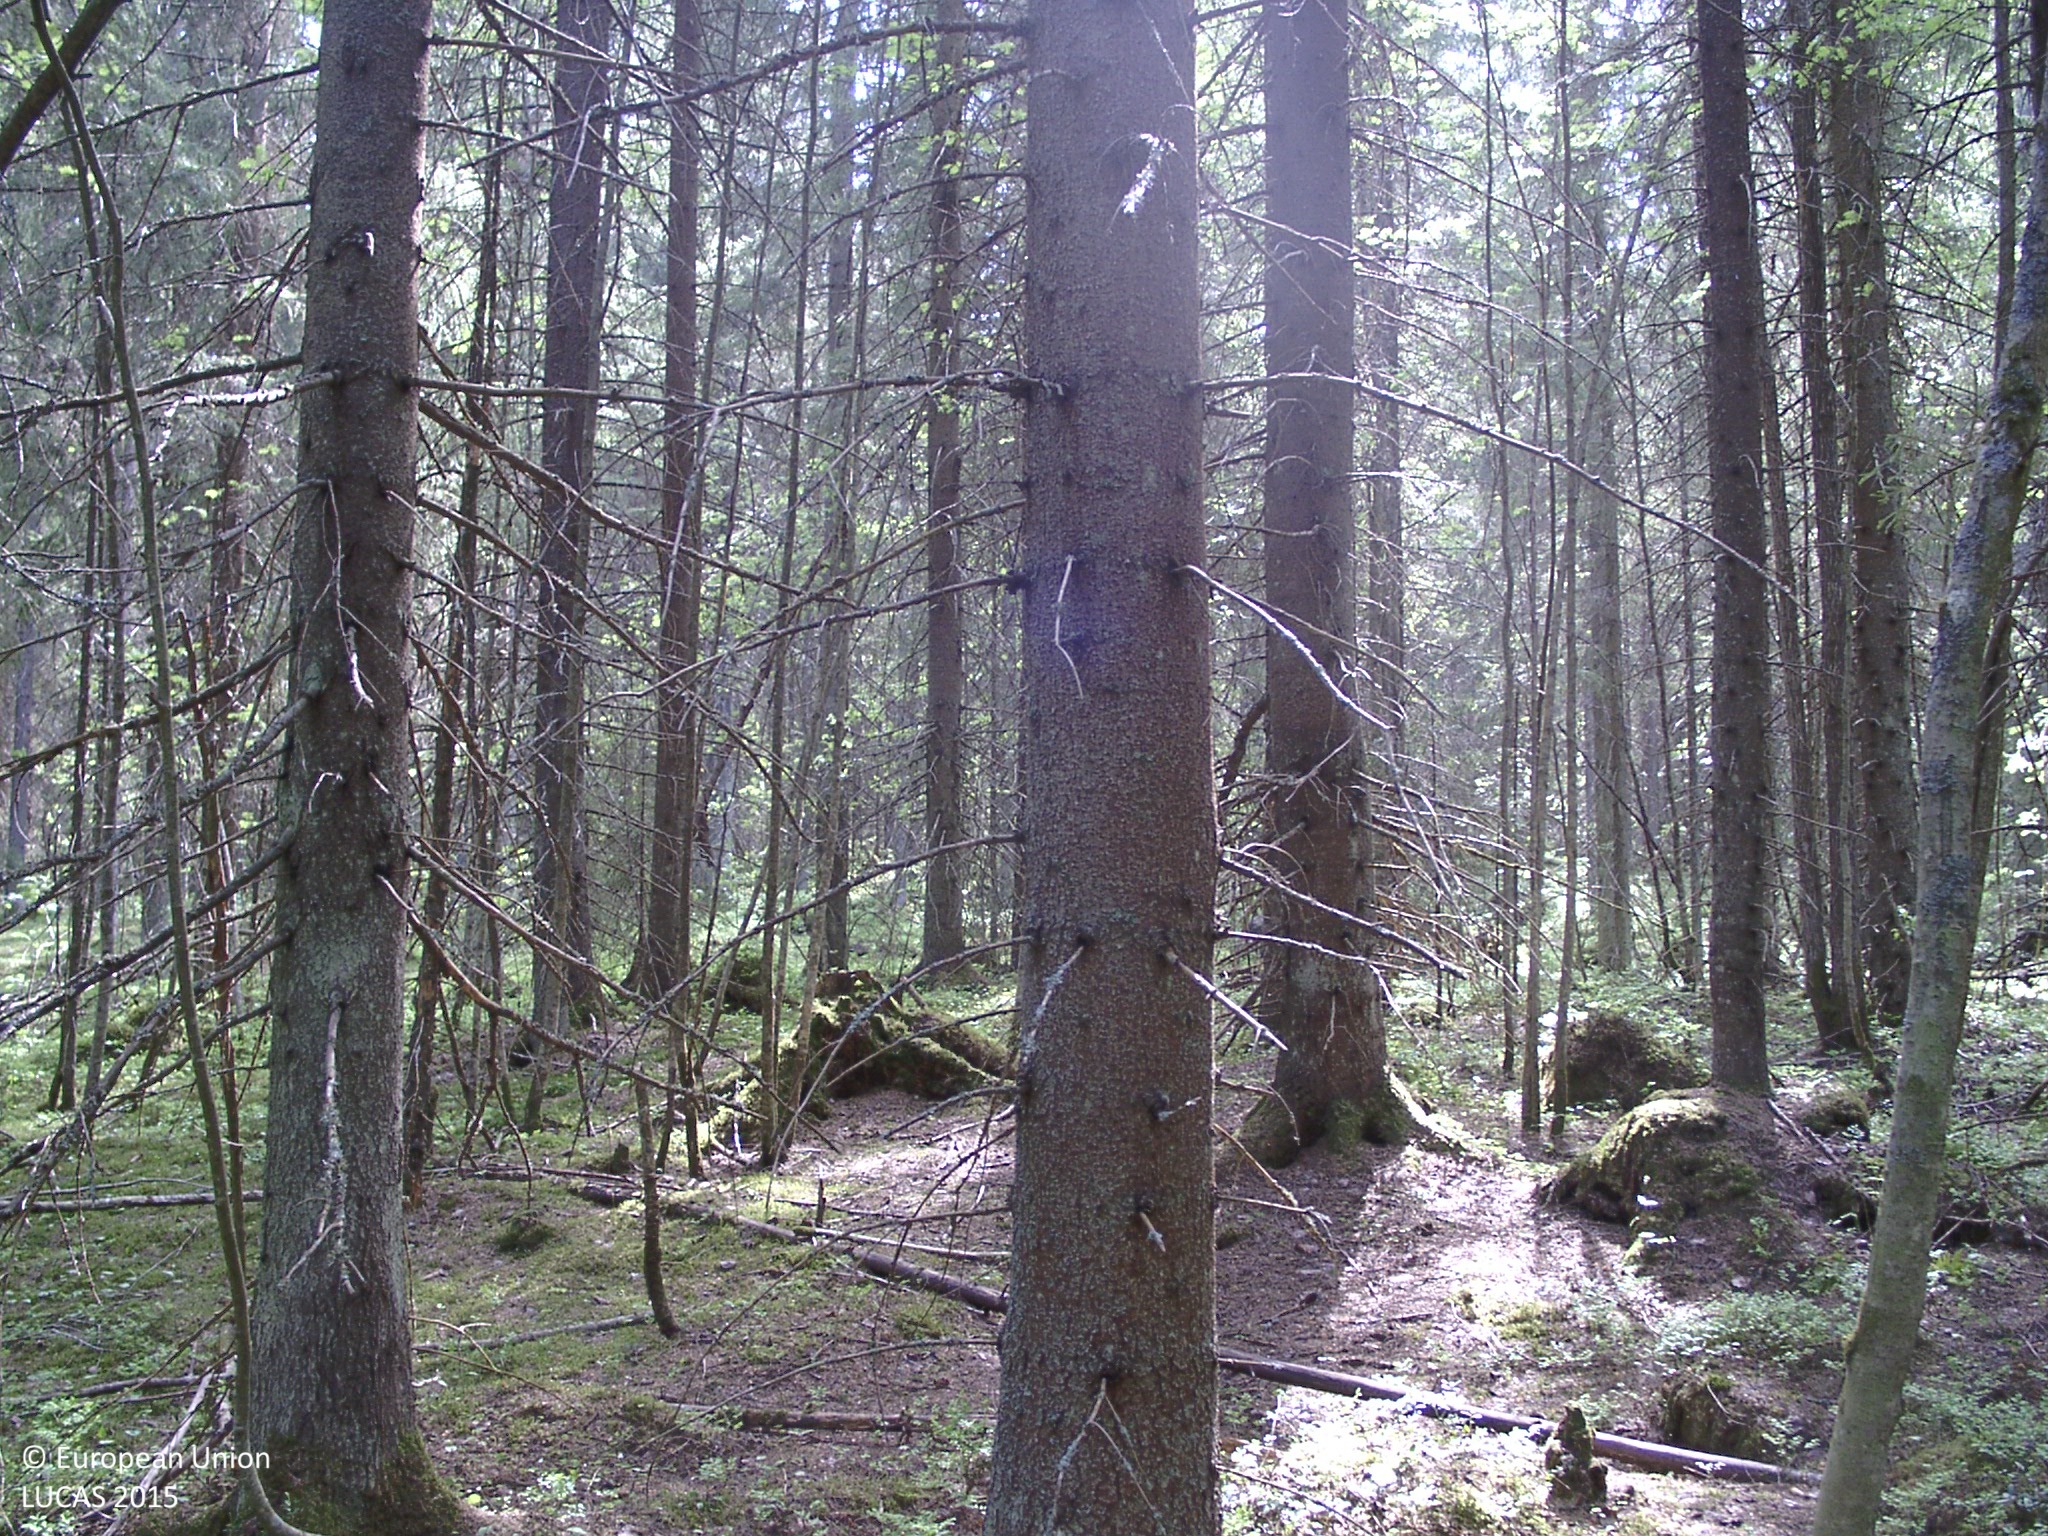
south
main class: Woodland
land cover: Spruce dominated coniferous woodland
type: boreal forest
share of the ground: > 75 %
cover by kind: coniferous forest trees 70 %, shrubs 10 %, lichens and mosses 10 %, broadleaved forest trees 5 %, herbaceous plants 5 %
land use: Forestry
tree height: > 5 m
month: June
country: FI
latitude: 62.2083
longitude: 25.6719
